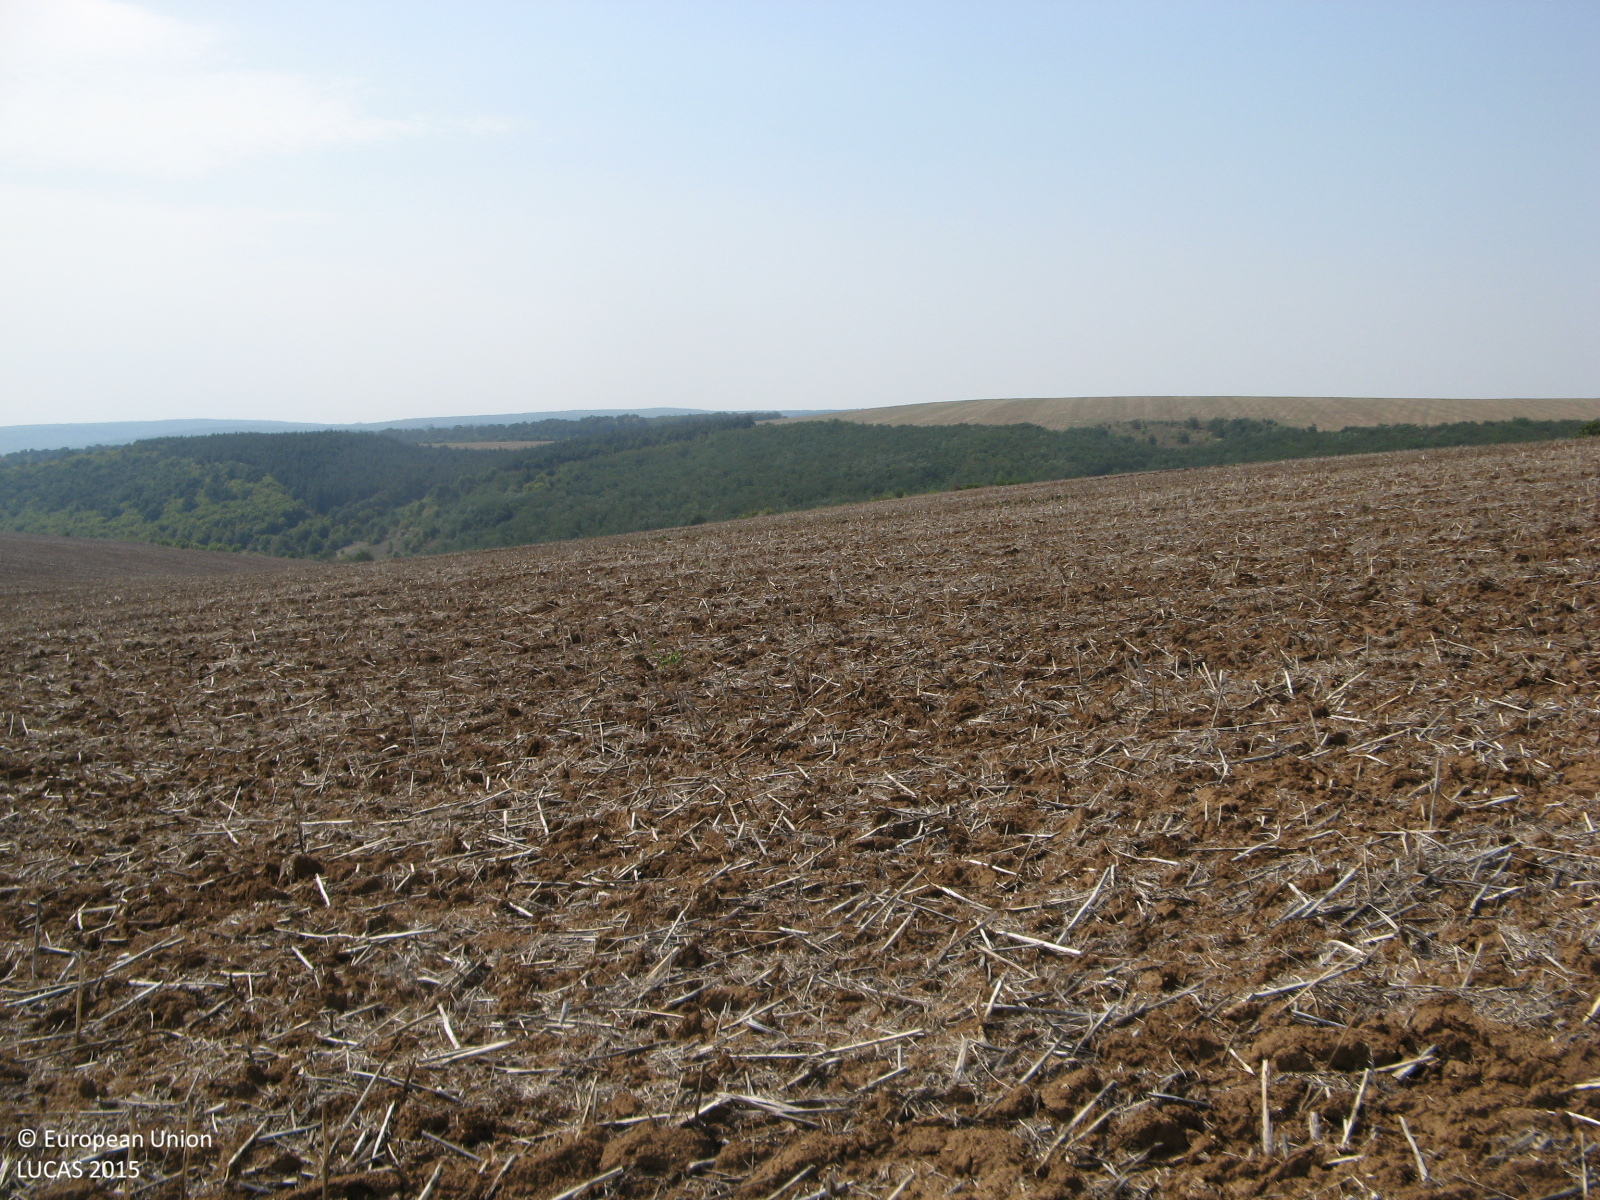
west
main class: Cropland
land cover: Rape and turnip rape
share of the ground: < 10 %
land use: Agriculture (excluding fallow land and kitchen gardens)
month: August
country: BG
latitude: 43.3976
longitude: 25.8549
